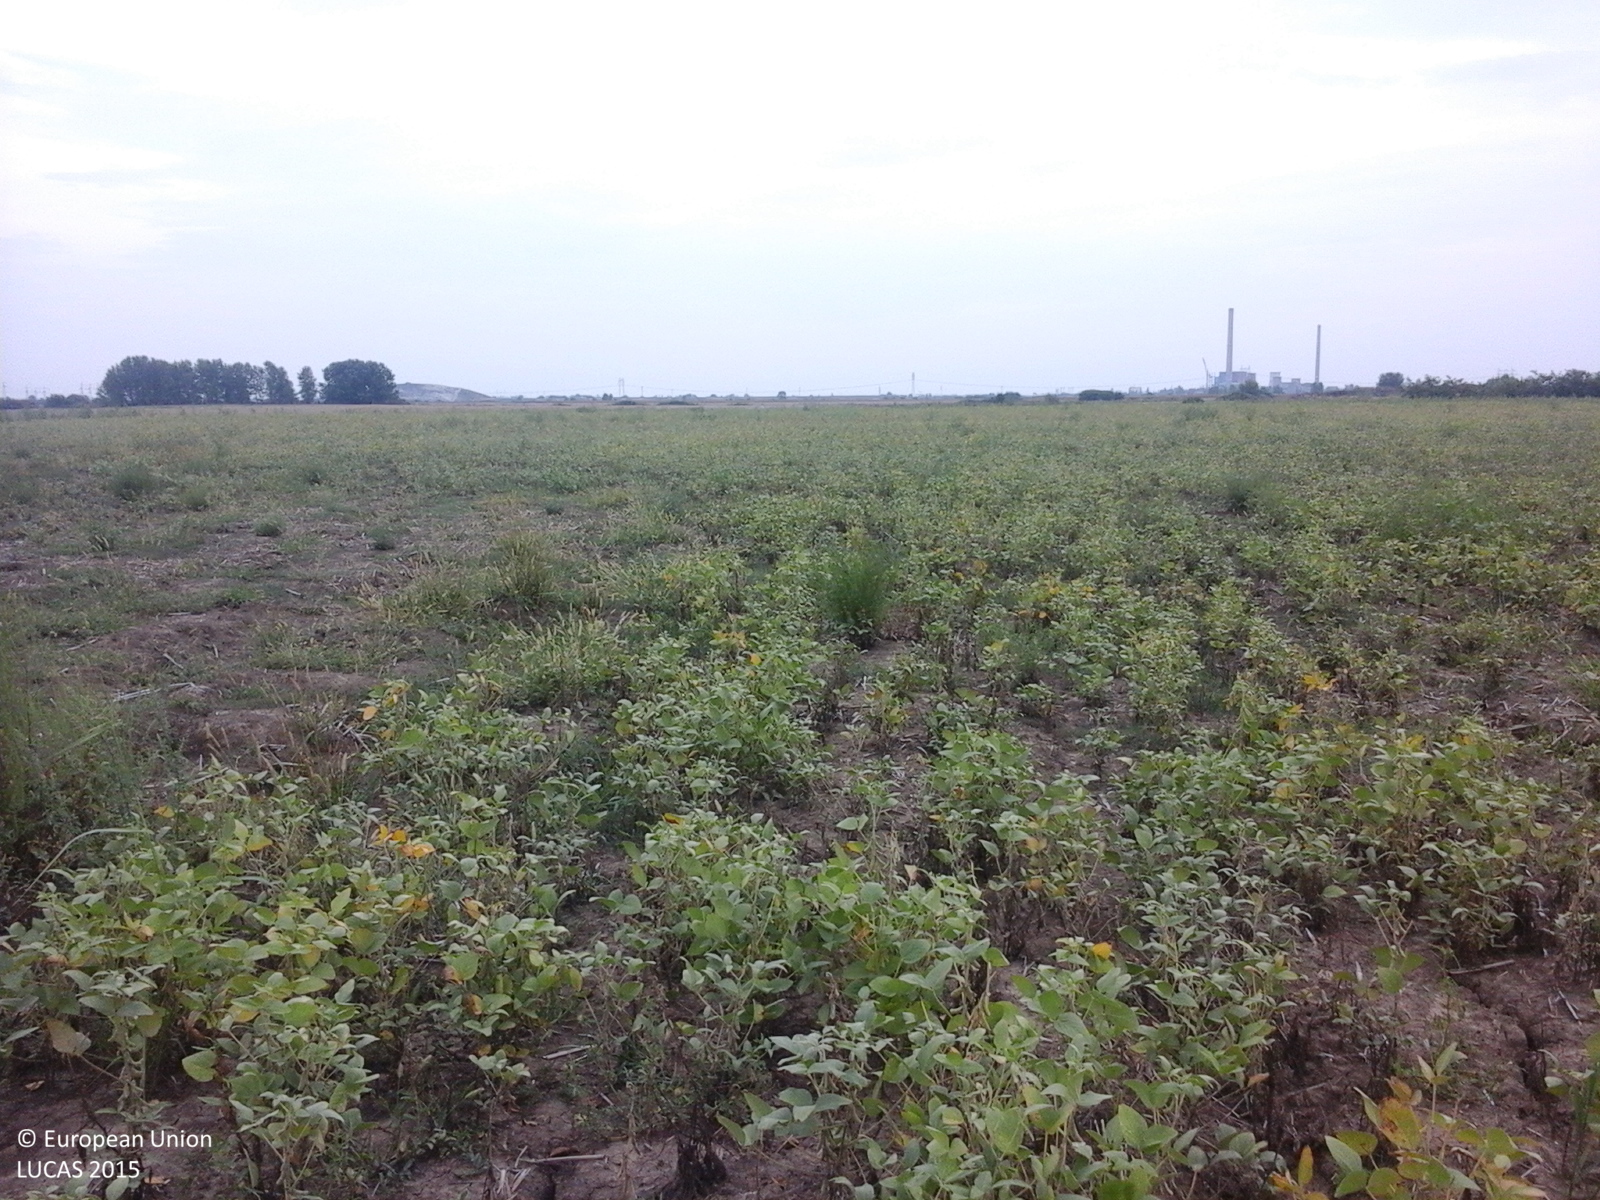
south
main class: Cropland
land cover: Soya
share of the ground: > 75 %
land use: Agriculture (excluding fallow land and kitchen gardens)
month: August
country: RO
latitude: 46.2558
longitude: 21.3334
